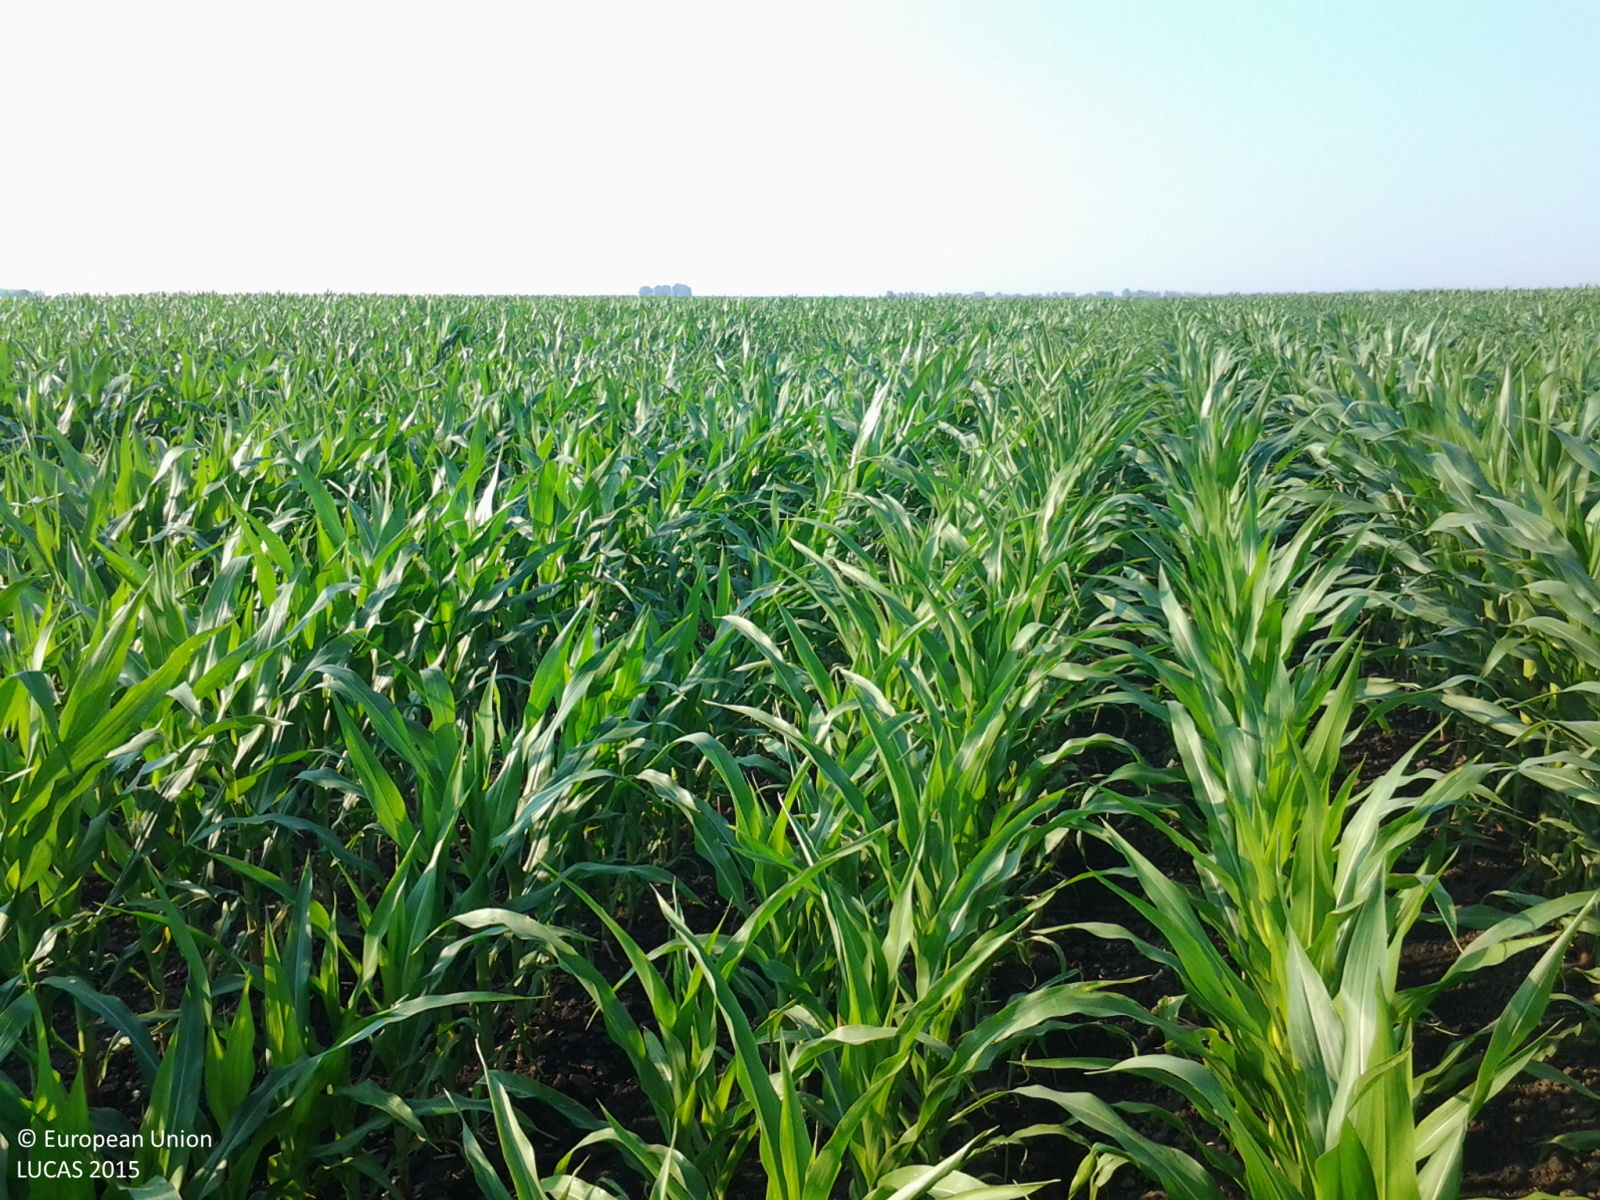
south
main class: Cropland
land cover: Maize
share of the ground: > 75 %
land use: Agriculture (excluding fallow land and kitchen gardens)
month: July
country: HU
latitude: 47.0091
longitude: 20.3528
